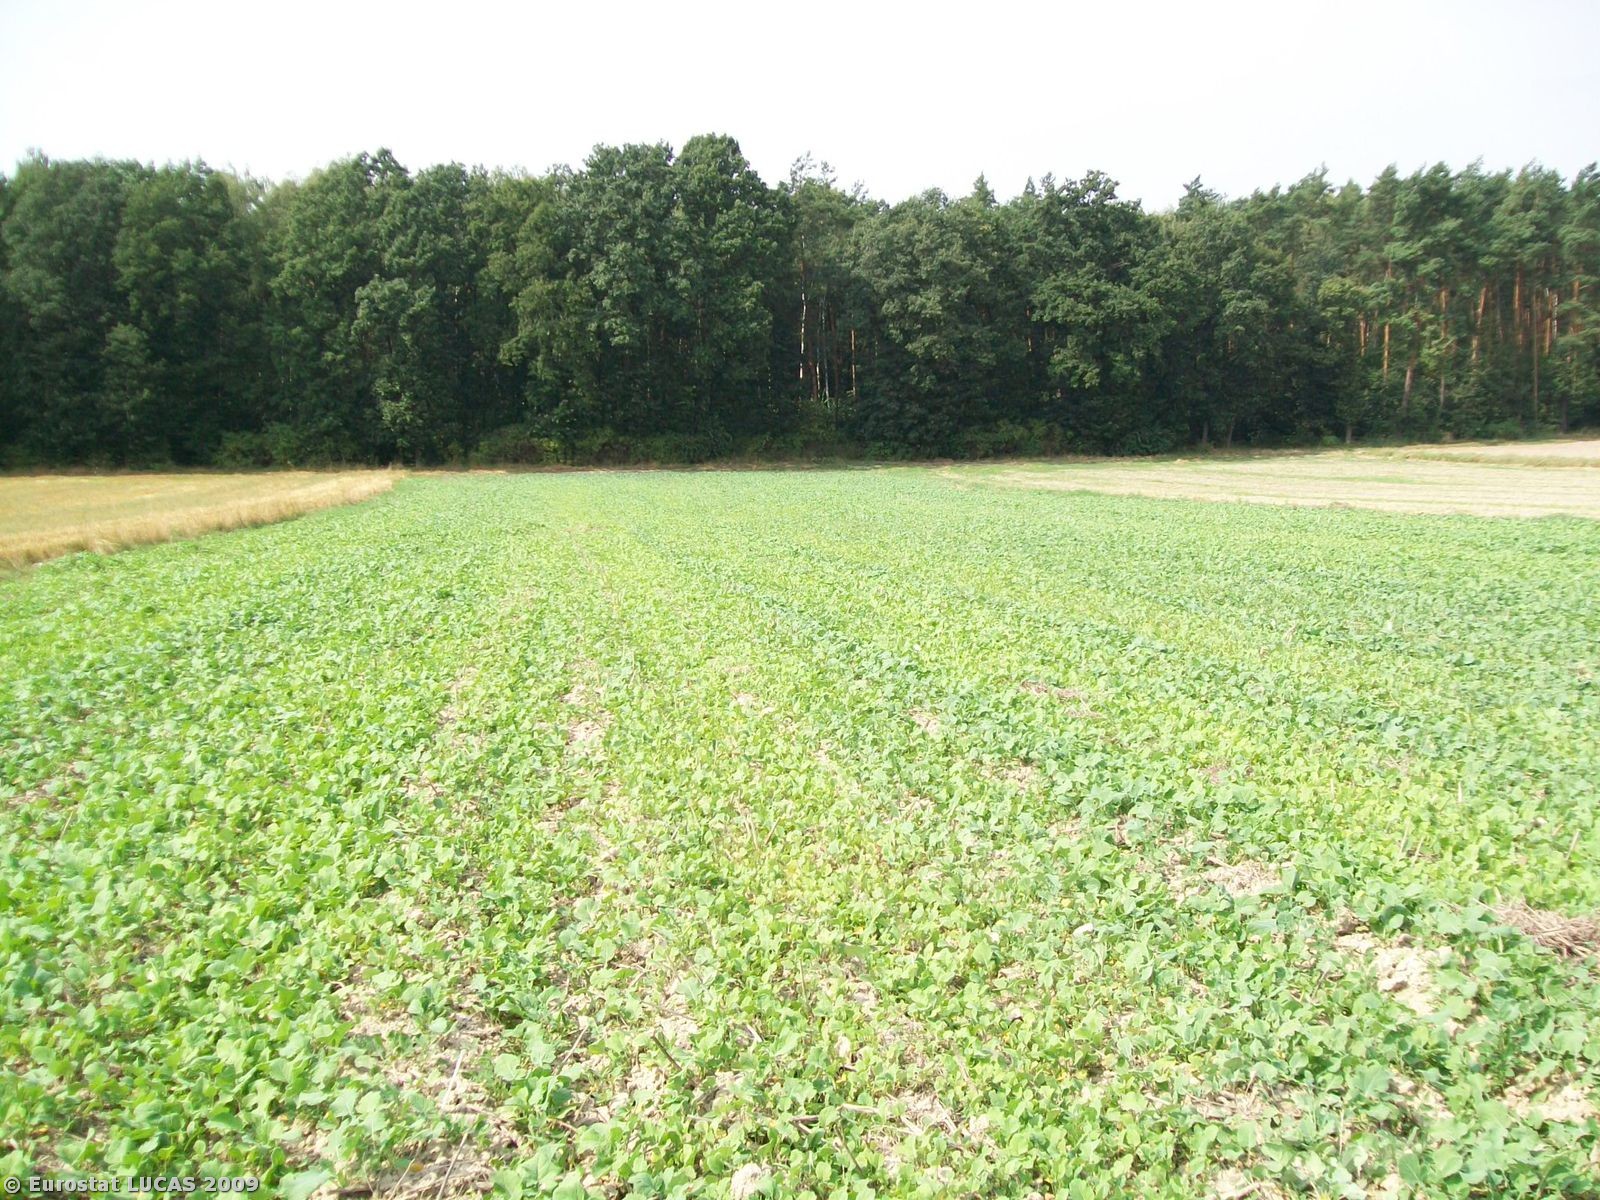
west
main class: Cropland
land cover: Rape and turnip rape
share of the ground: < 10 %
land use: Agriculture (excluding fallow land and kitchen gardens)
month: August
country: PL
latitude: 51.1352
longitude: 17.9473
